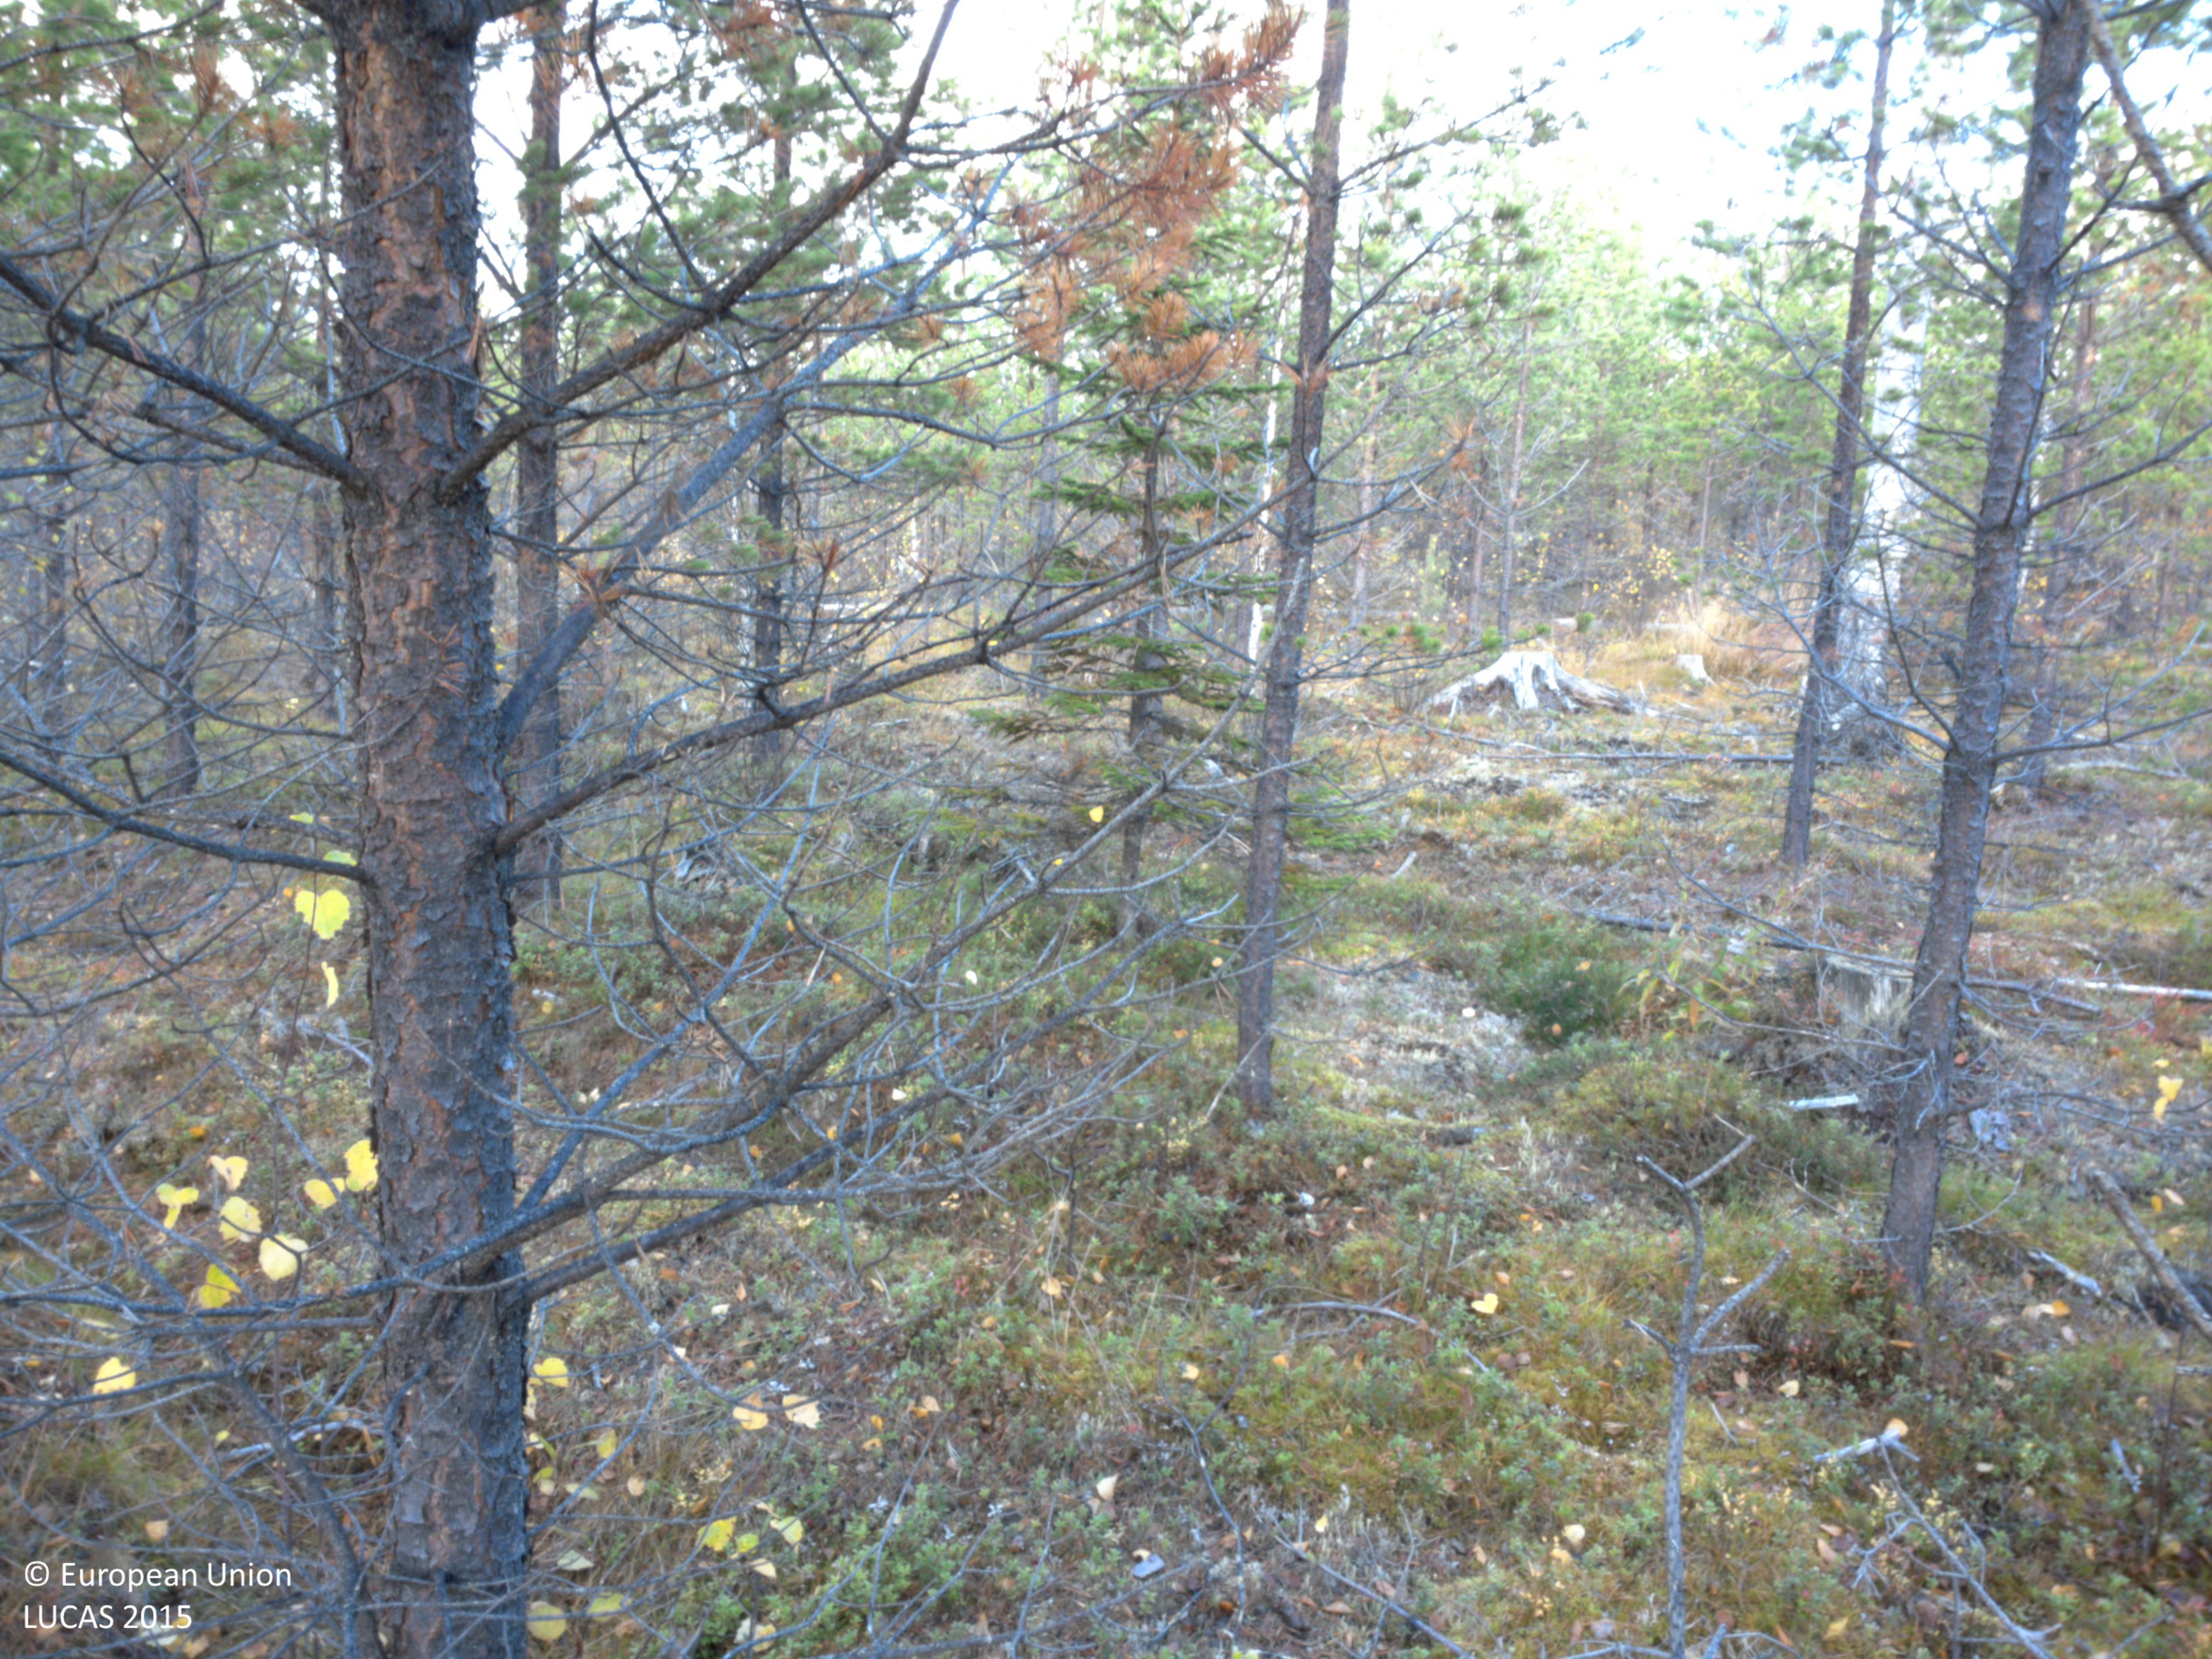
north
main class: Woodland
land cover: Pine dominated coniferous woodland
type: boreal forest
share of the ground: > 75 %
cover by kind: coniferous forest trees 75 %, shrubs 10 %, broadleaved forest trees 5 %, herbaceous plants 5 %, lichens and mosses 5 %
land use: Forestry
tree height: < 5 m
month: October
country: SE
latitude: 64.8893
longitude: 18.3070
